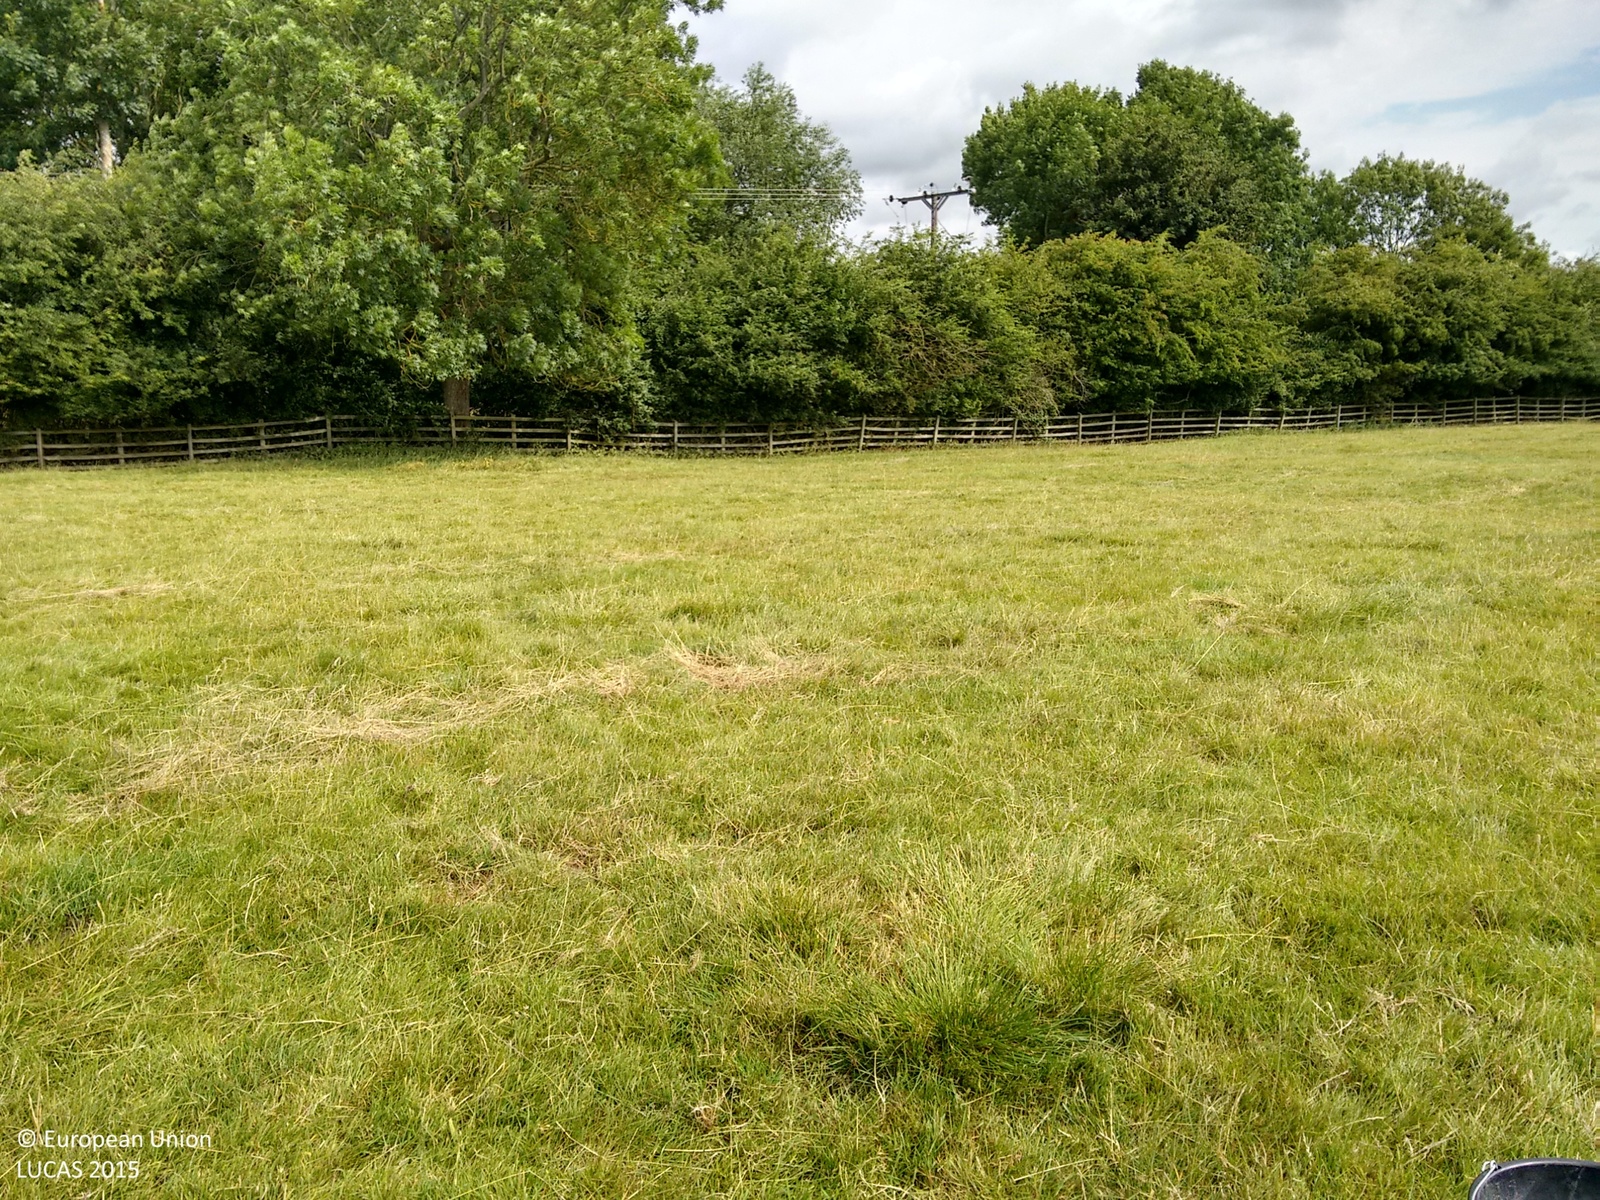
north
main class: Grassland
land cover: Grassland without tree/shrub cover
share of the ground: > 75 %
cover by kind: herbaceous plants 100 %
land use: Agriculture (excluding fallow land and kitchen gardens)
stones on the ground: < 10 %
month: July
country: GB
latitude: 52.6367
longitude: -0.6943
